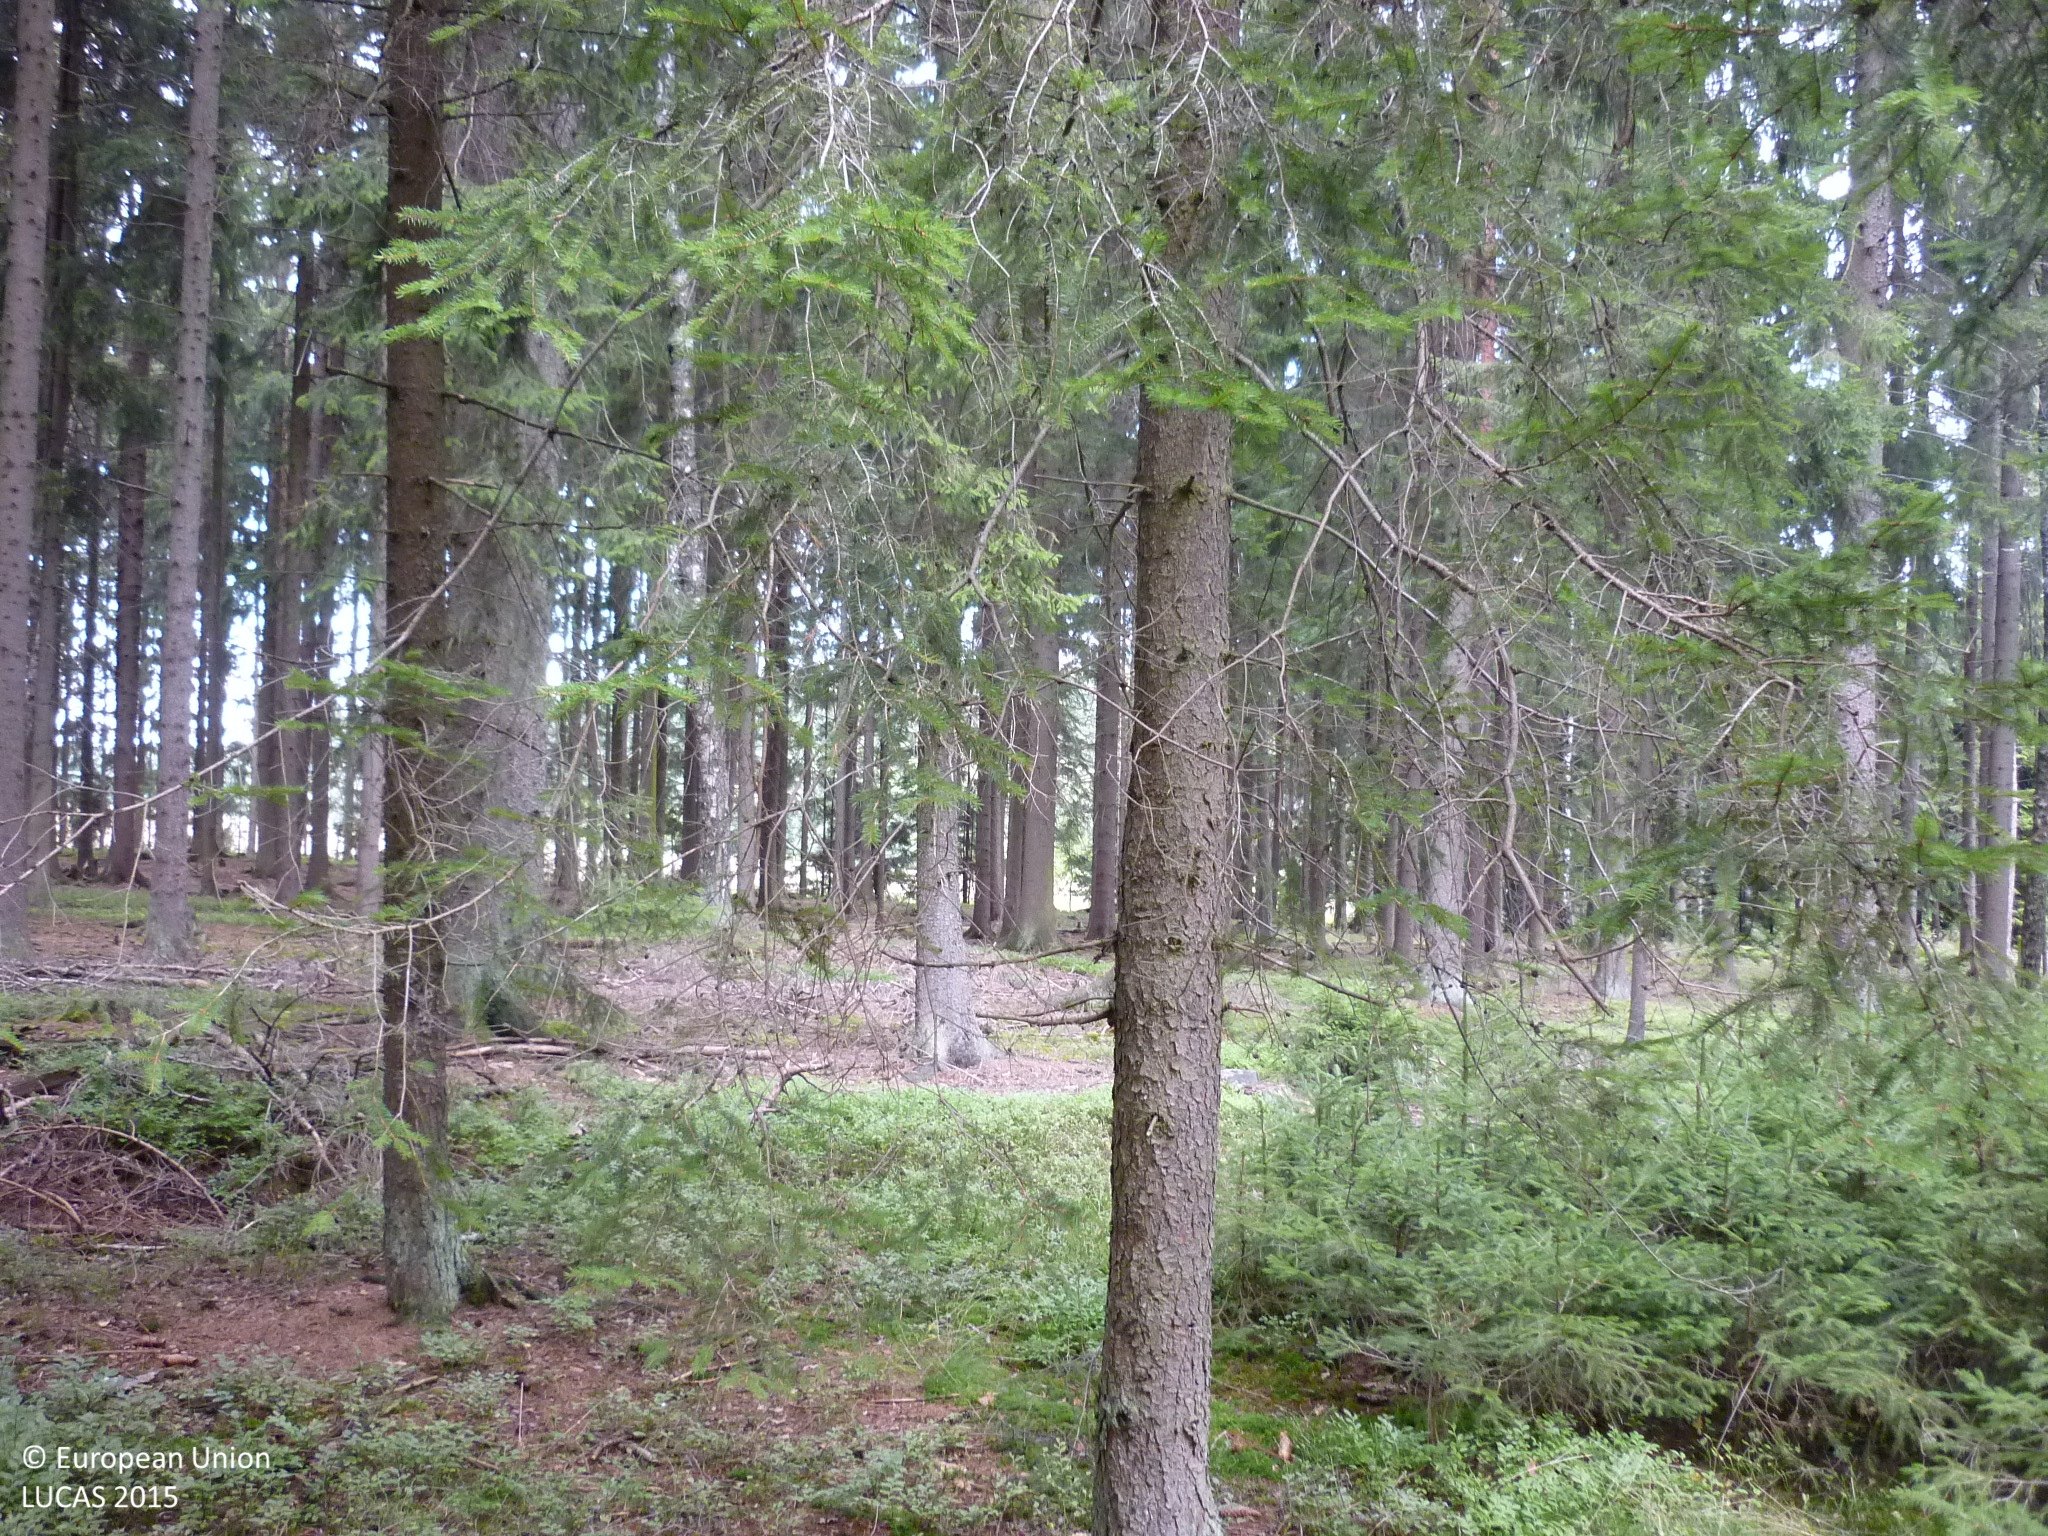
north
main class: Woodland
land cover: Spruce dominated coniferous woodland
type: hemiboreal forest and nemoral coniferous forest and mixed broadleaved-coniferous forest
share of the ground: > 75 %
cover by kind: coniferous forest trees 95 %, shrubs 5 %
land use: Forestry
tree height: > 5 m
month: September
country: AT
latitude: 48.9351
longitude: 15.0941
